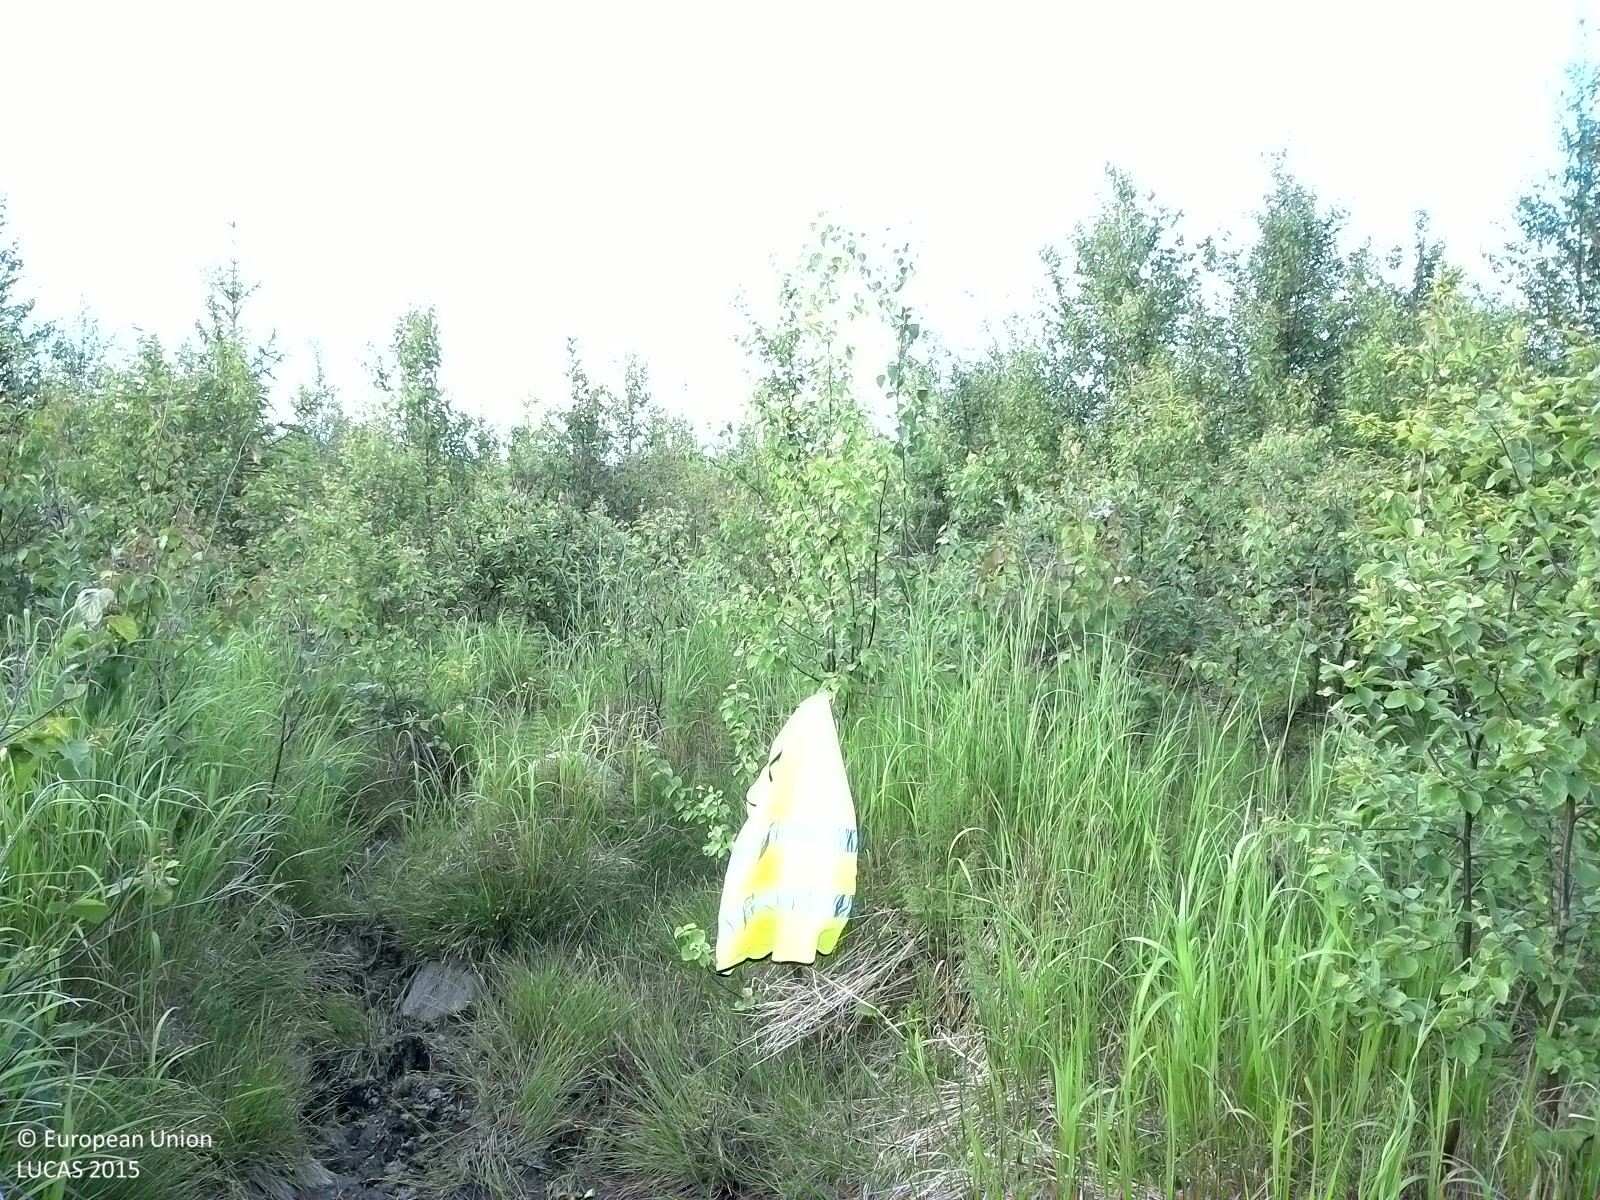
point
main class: Woodland
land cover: Broadleaved woodland
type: boreal forest
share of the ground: 50 - 75 %
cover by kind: broadleaved forest trees 55 %, herbaceous plants 35 %, coniferous forest trees 5 %, unconsolidated bare surface 5 %
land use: Forestry
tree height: < 5 m
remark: Clear cut
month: July
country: SE
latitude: 62.1836
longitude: 16.8773
